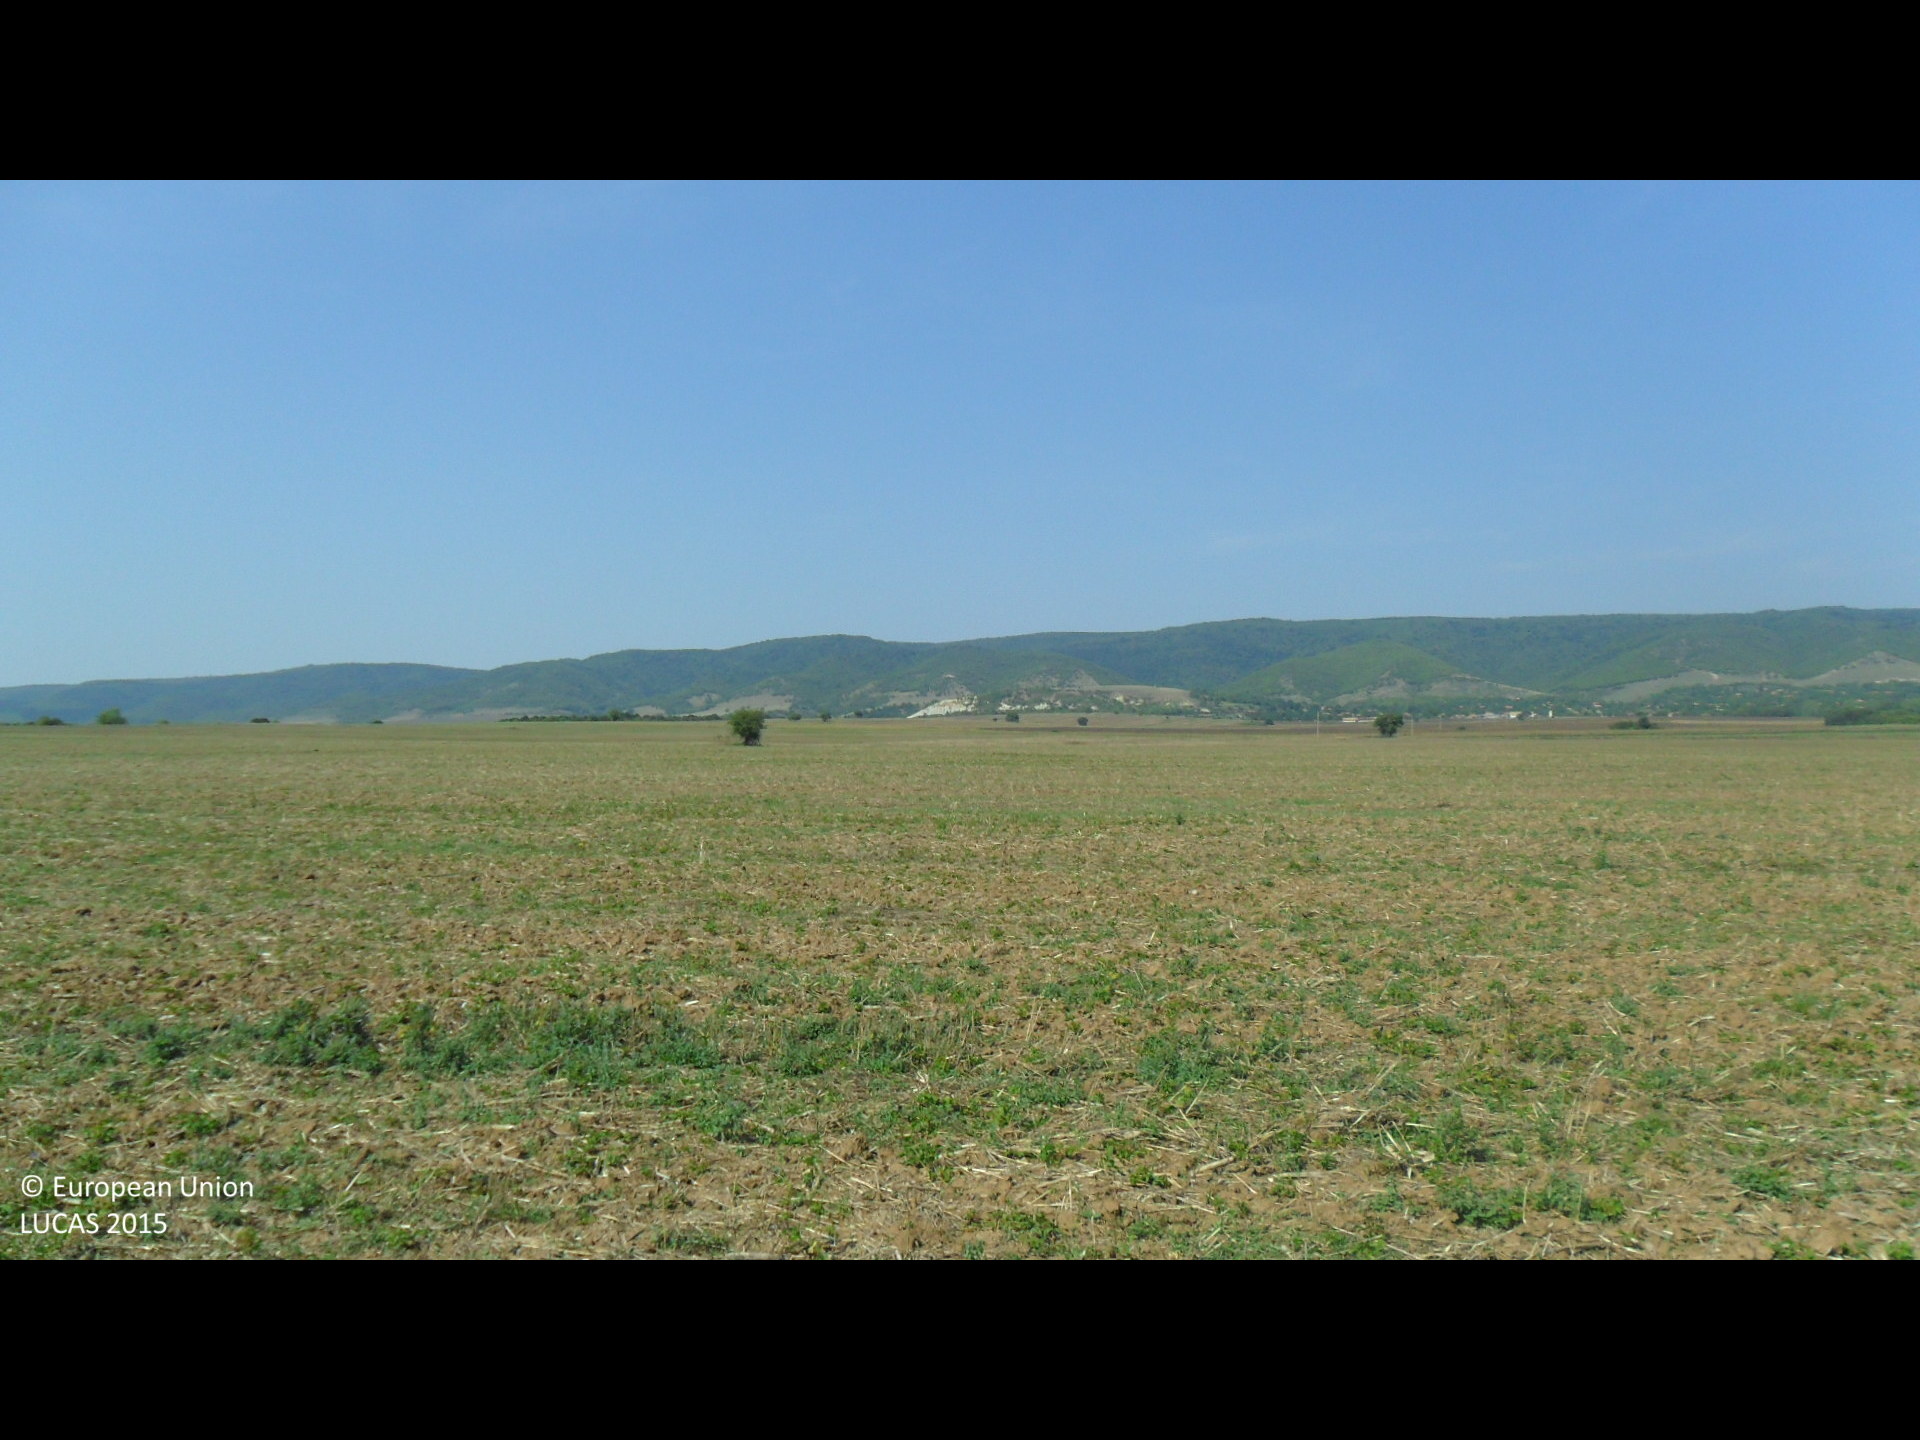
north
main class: Cropland
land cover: Common wheat
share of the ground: < 10 %
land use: Agriculture (excluding fallow land and kitchen gardens)
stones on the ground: < 10 %
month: September
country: BG
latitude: 43.0994
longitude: 26.6788
